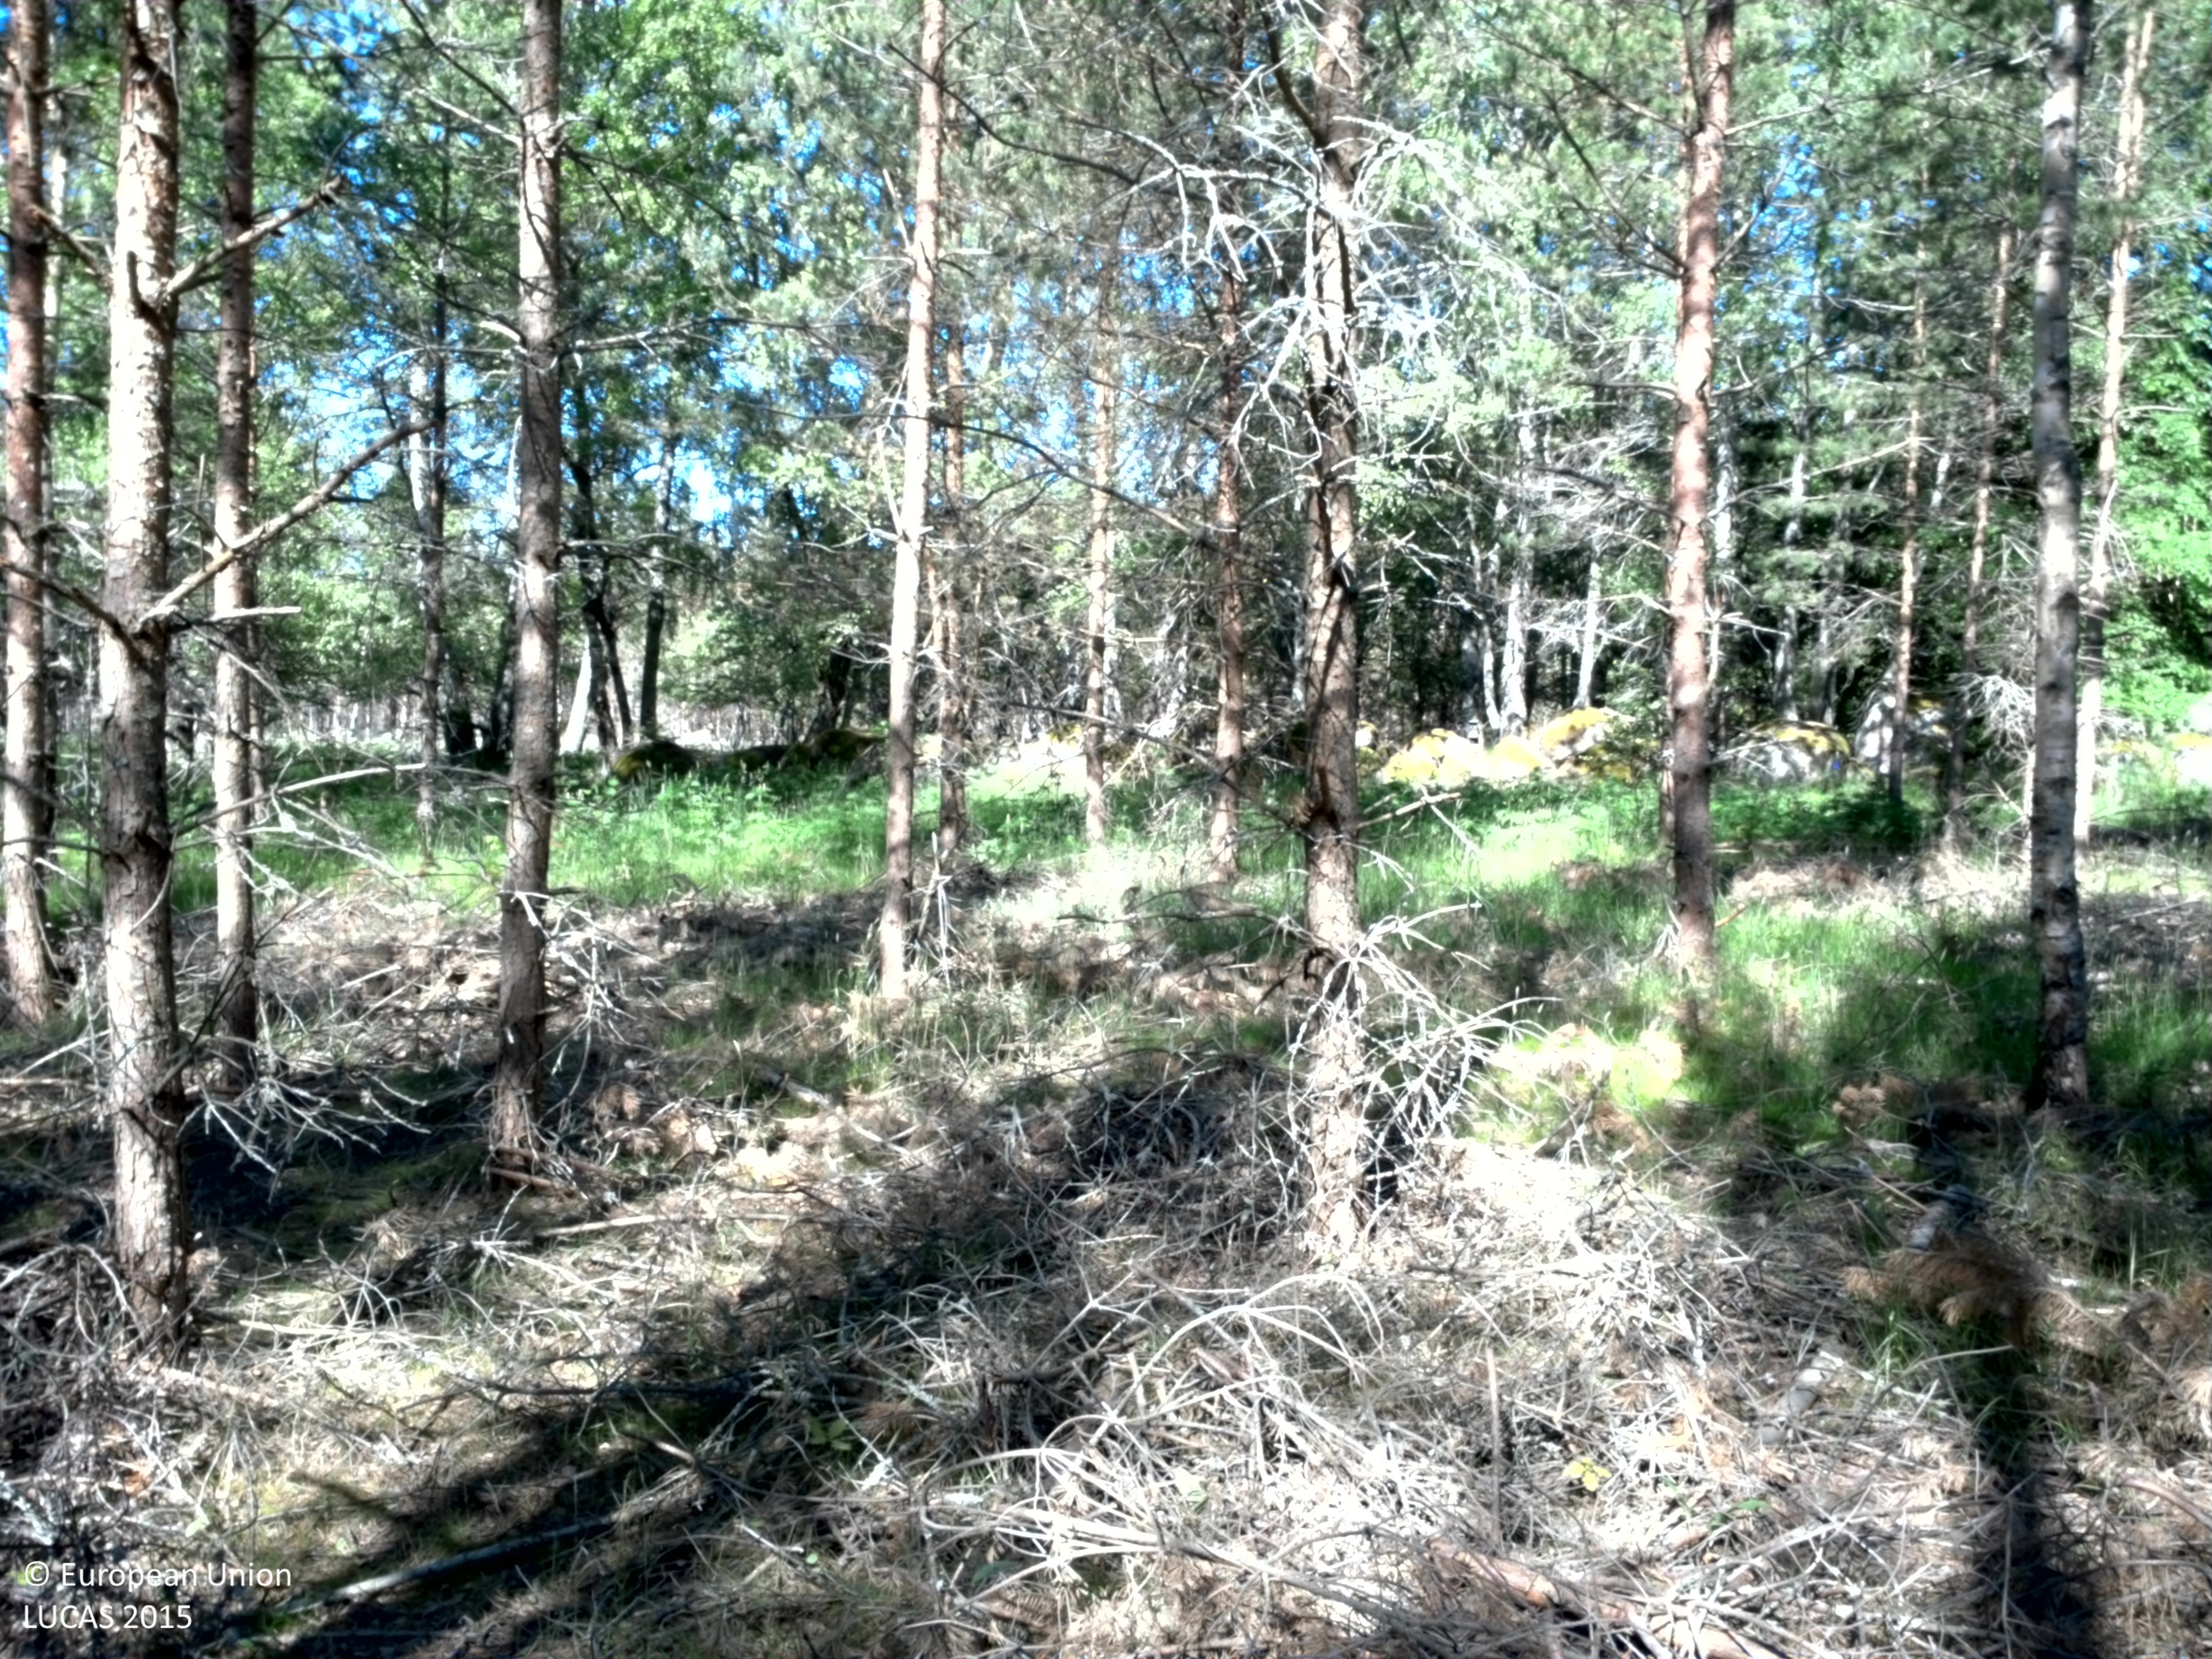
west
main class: Woodland
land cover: Pine dominated coniferous woodland
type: boreal forest
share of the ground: 25 - 50 %
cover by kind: coniferous forest trees 50 %, herbaceous plants 20 %, unconsolidated bare surface 10 %
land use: Community services
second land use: Forestry
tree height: > 5 m
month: June
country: SE
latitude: 58.5044
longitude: 14.5069
